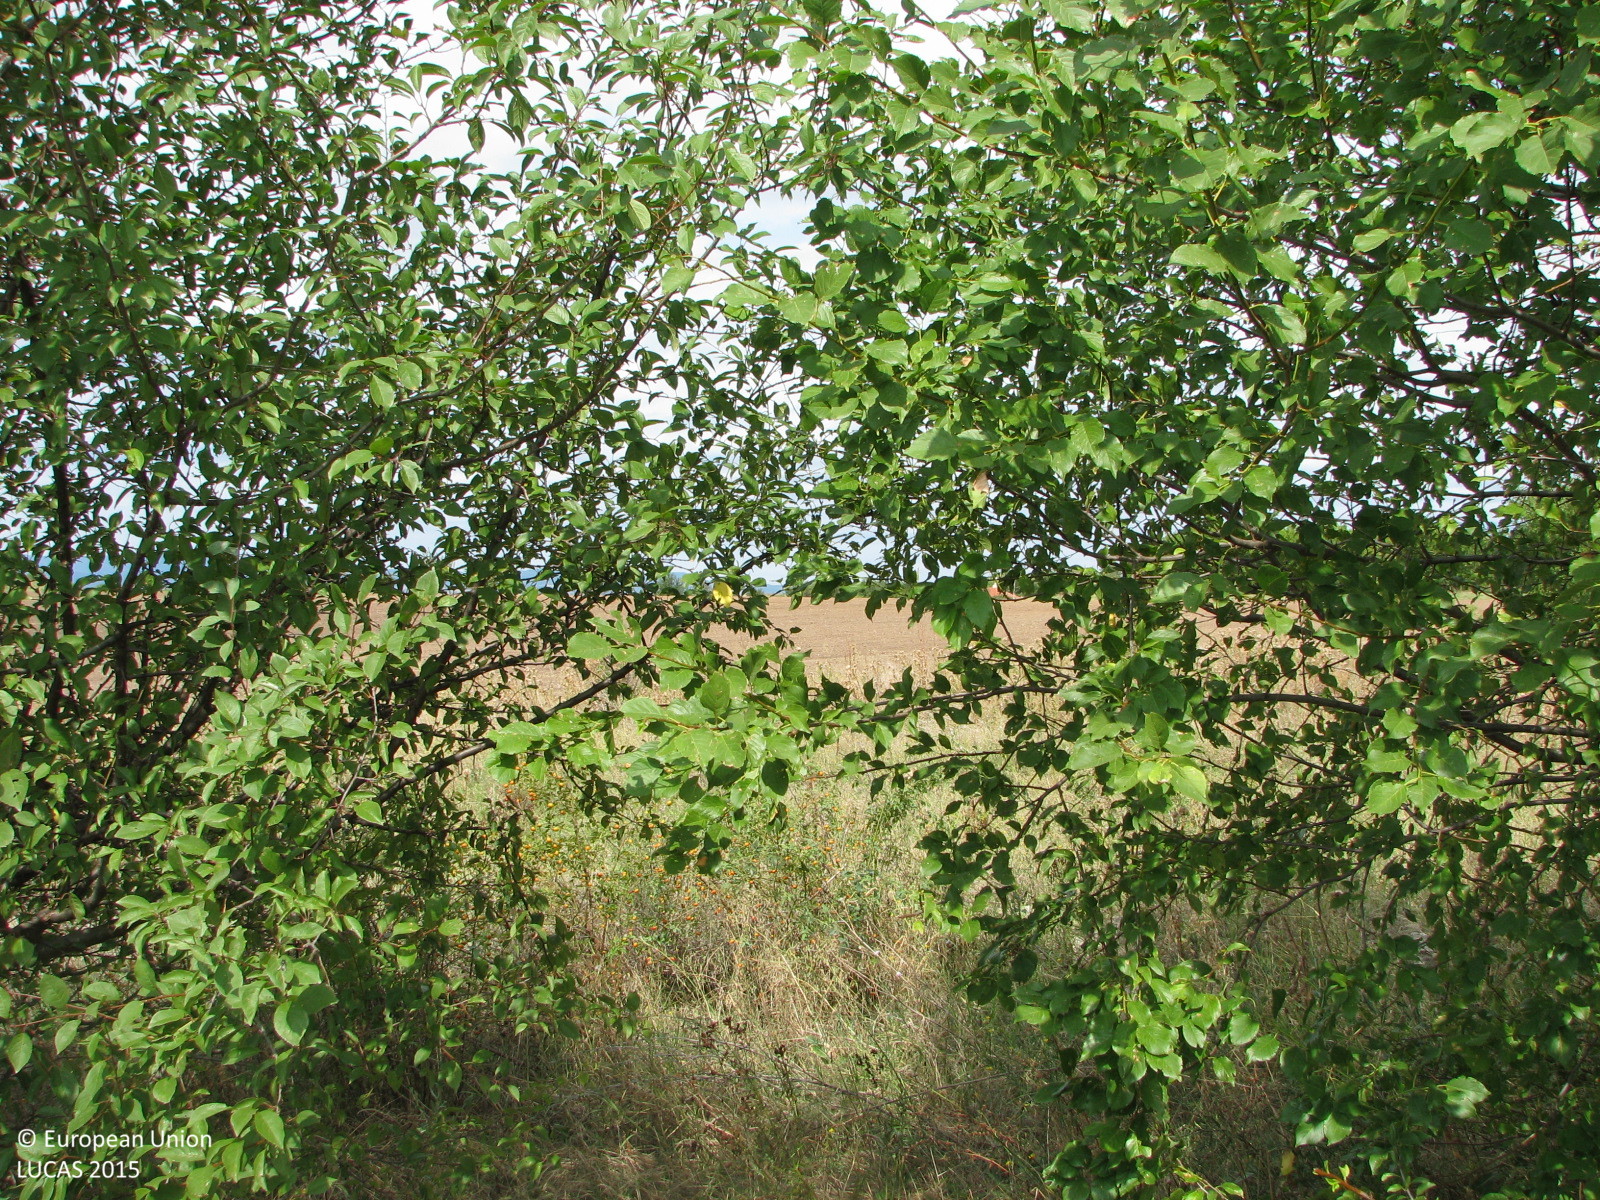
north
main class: Grassland
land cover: Grassland with sparse tree/shrub cover
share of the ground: > 75 %
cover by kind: herbaceous plants 90 %, broadleaved forest trees 5 %, shrubs 5 %
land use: Semi-natural and natural areas not in use
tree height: < 5 m
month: September
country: BG
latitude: 42.4102
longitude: 26.0598
